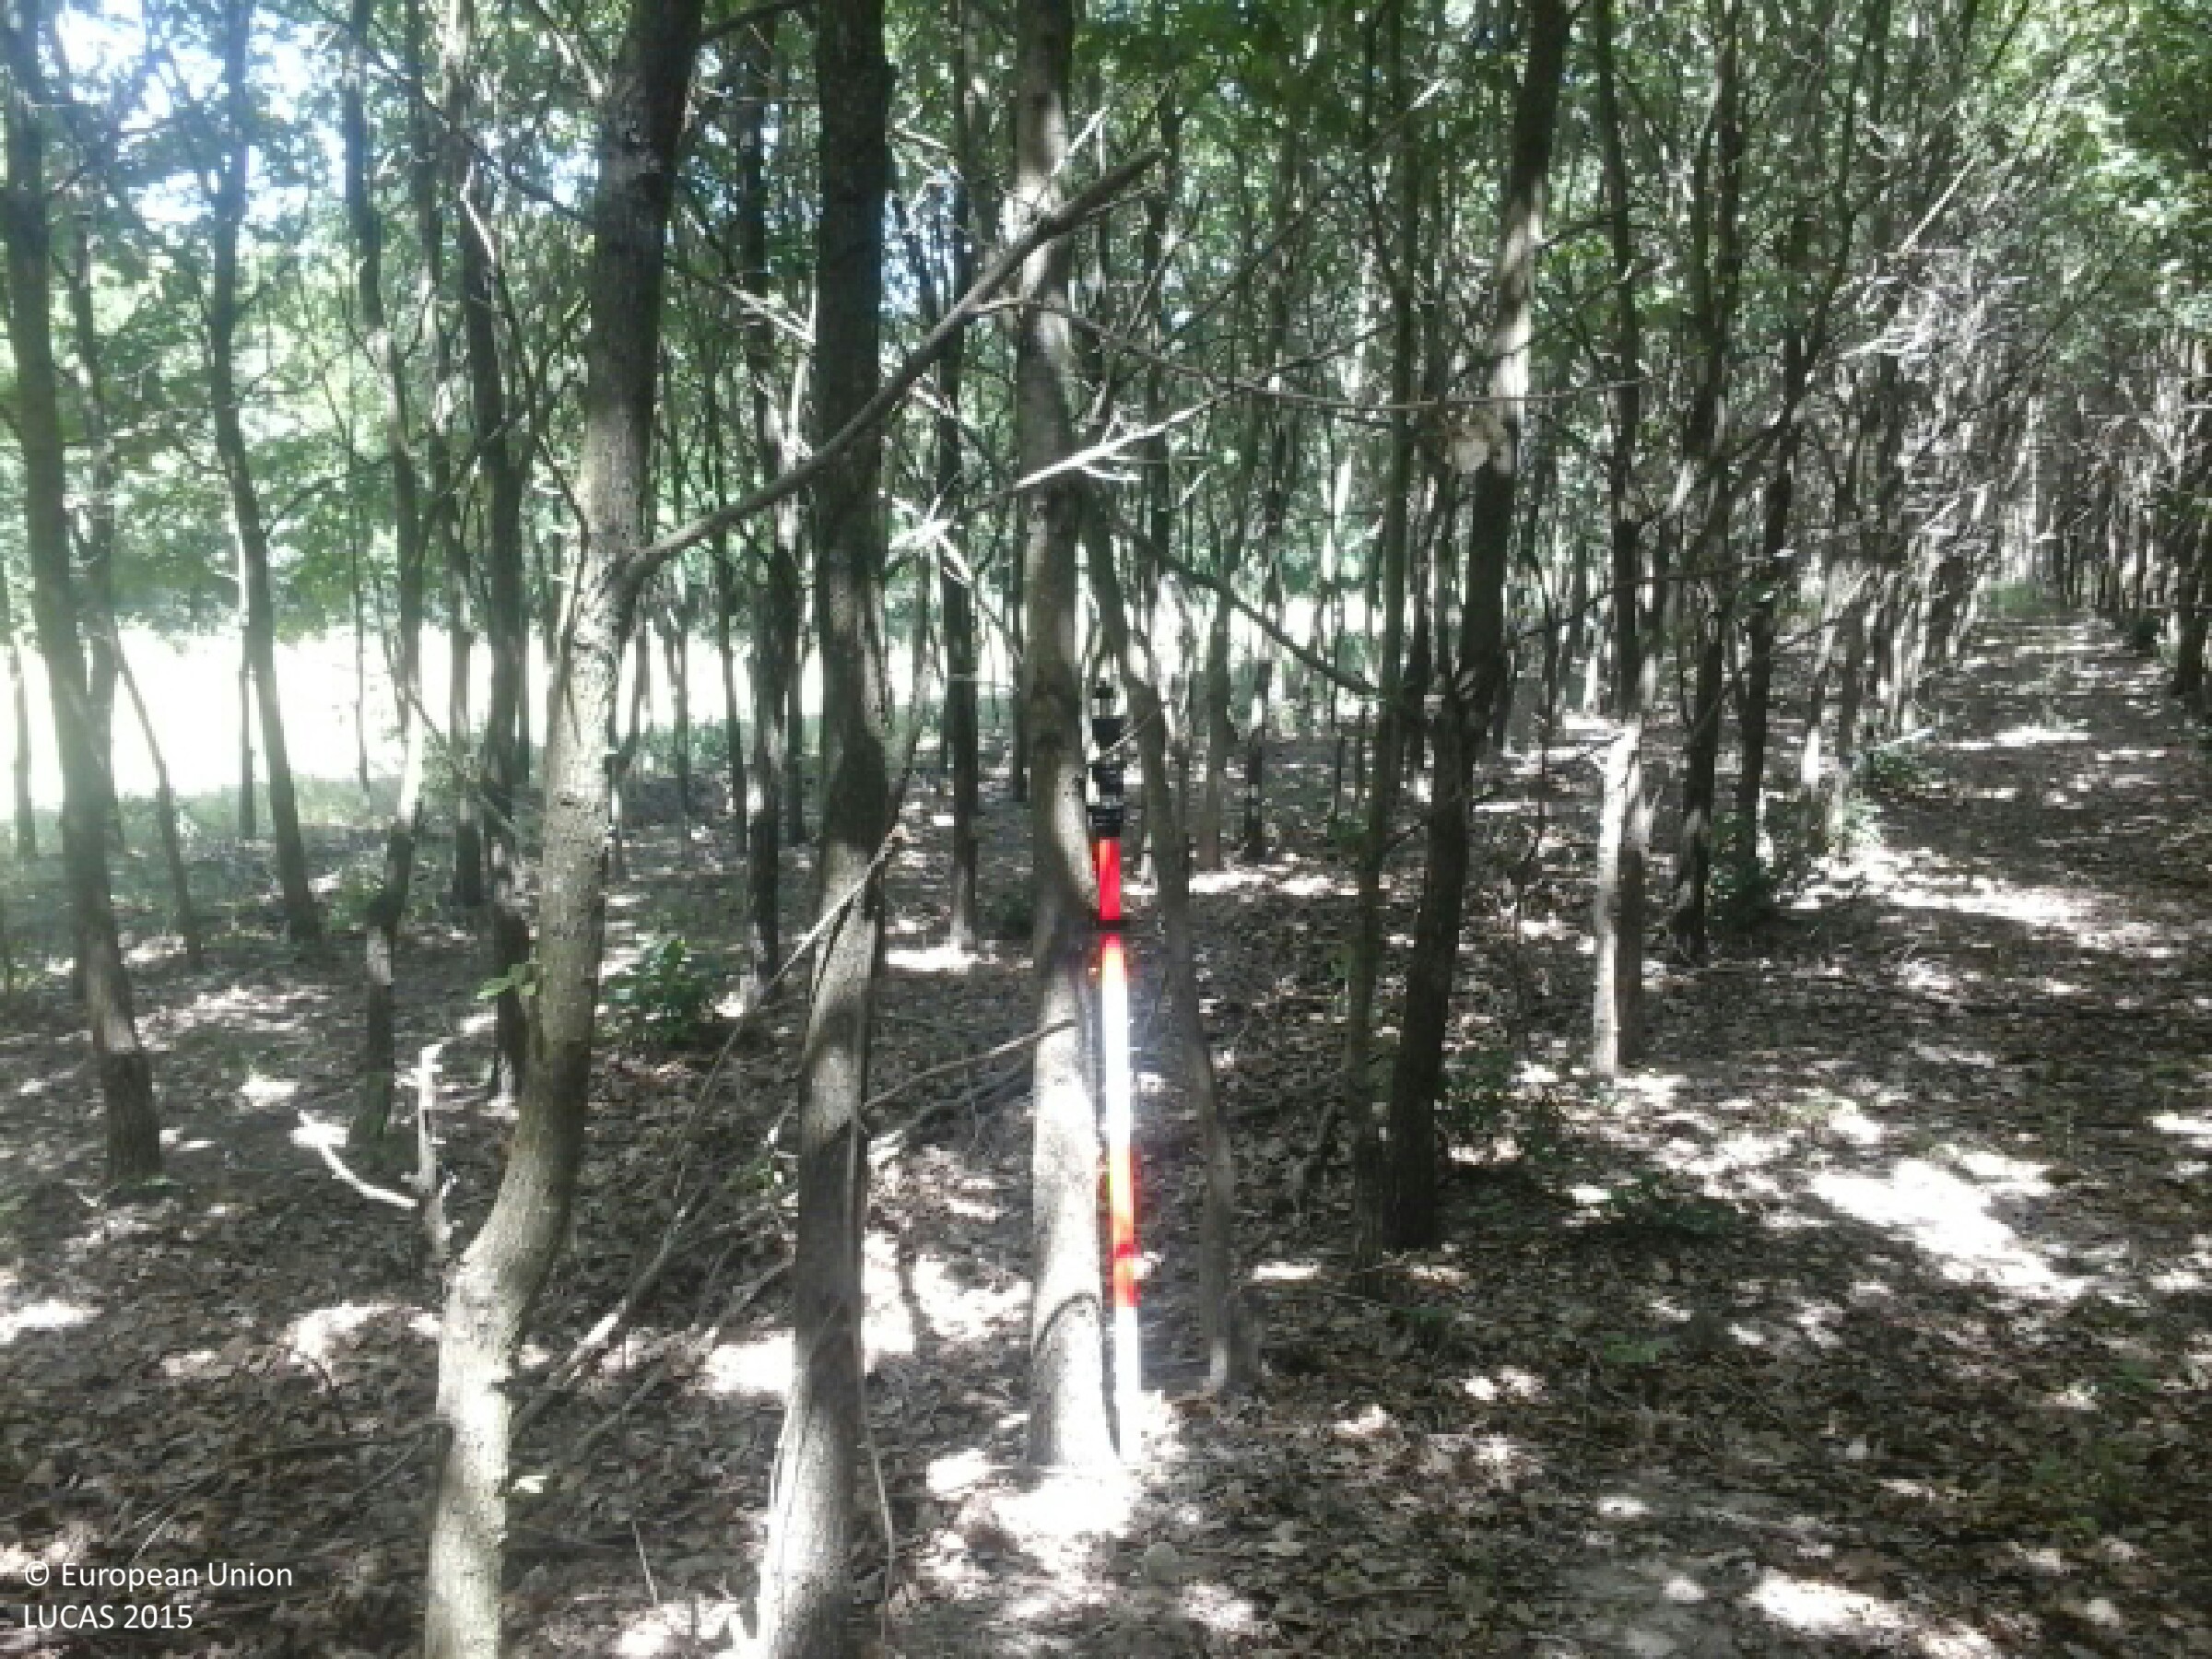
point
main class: Woodland
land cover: Broadleaved woodland
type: mesophytic deciduous forest
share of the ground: > 75 %
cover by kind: broadleaved forest trees 95 %, coniferous forest trees 5 %
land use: Forestry
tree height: > 5 m
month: July
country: HU
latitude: 48.4442
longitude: 21.6069
